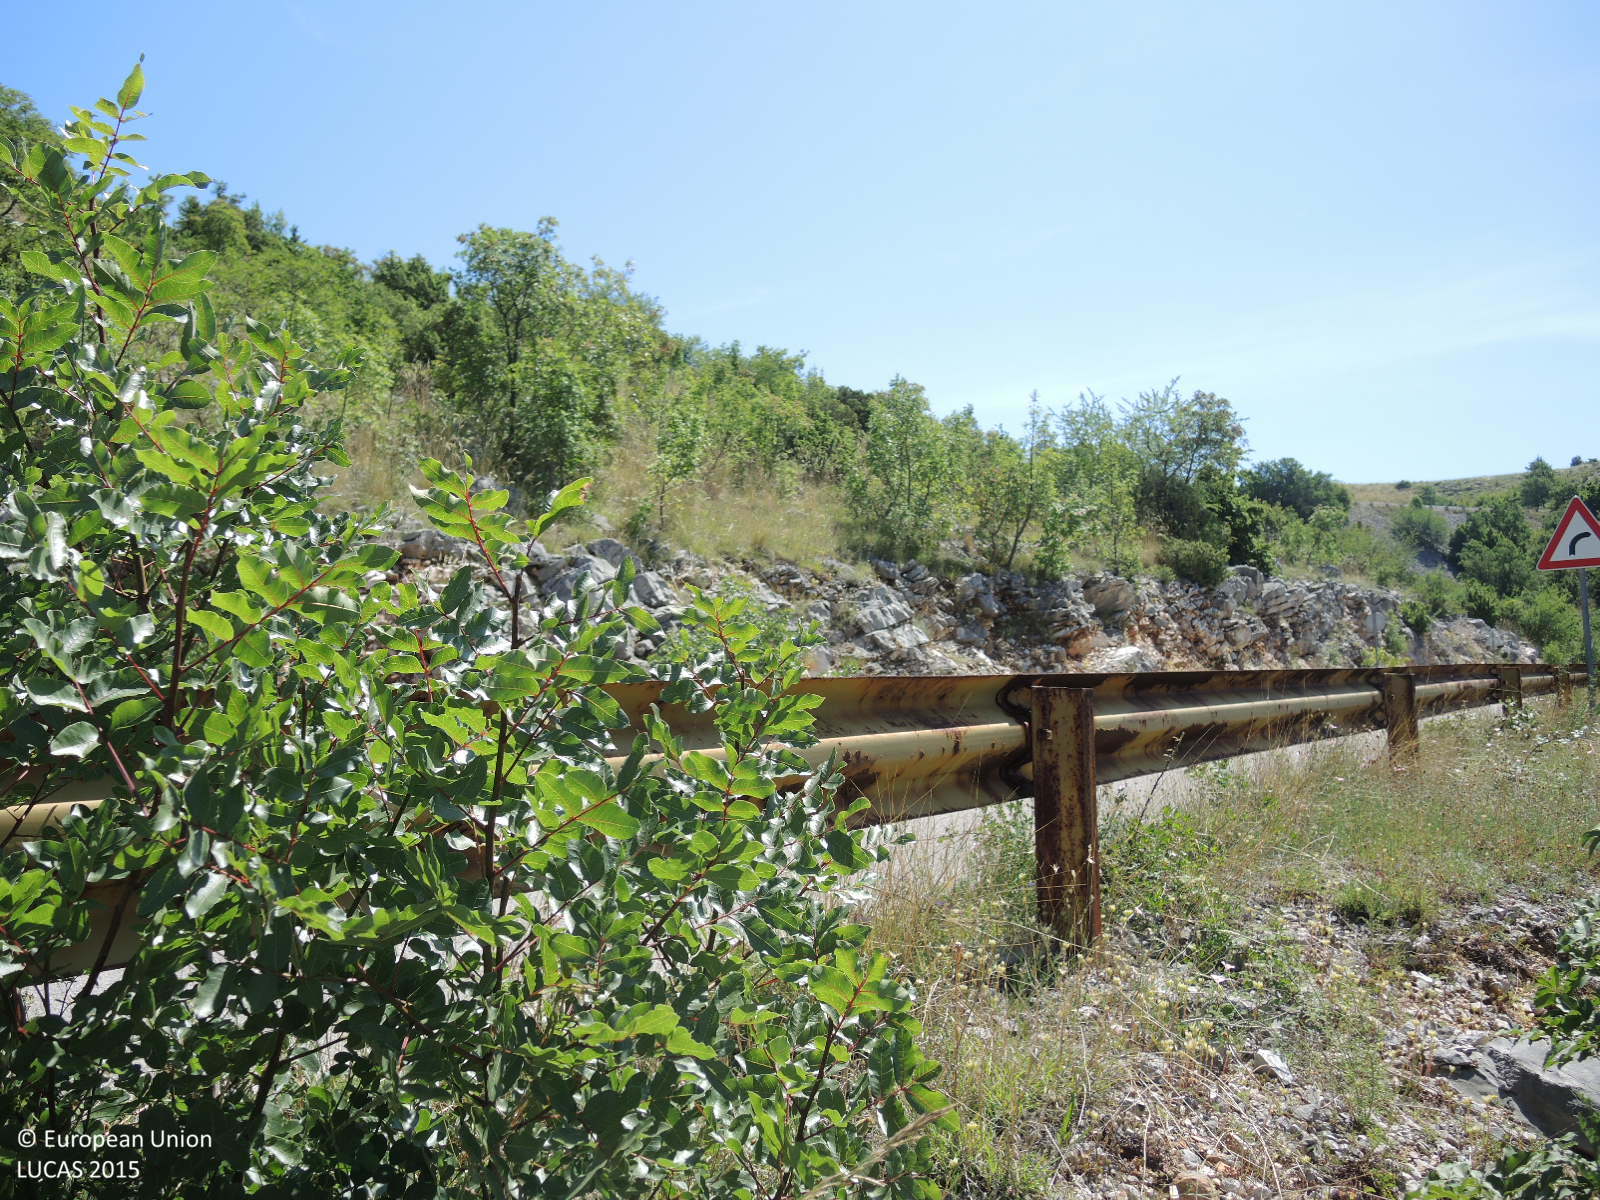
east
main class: Shrubland
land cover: Shrubland with sparse tree cover
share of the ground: 25 - 50 %
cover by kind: shrubs 45 %, herbaceous plants 20 %, unconsolidated bare surface 20 %, consolidated bare surface 10 %, broadleaved forest trees 5 %
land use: Semi-natural and natural areas not in use
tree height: < 5 m
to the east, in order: Shrubland with sparse tree cover; Fences; Paved roads, cycling and walking lanes; Grass margins; Shrubland with sparse tree cover; Rocks and stones; Railways; Rocks and stones; Grassland with sparse tree/shrub cover
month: June
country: HR
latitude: 43.6210
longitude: 16.2243
